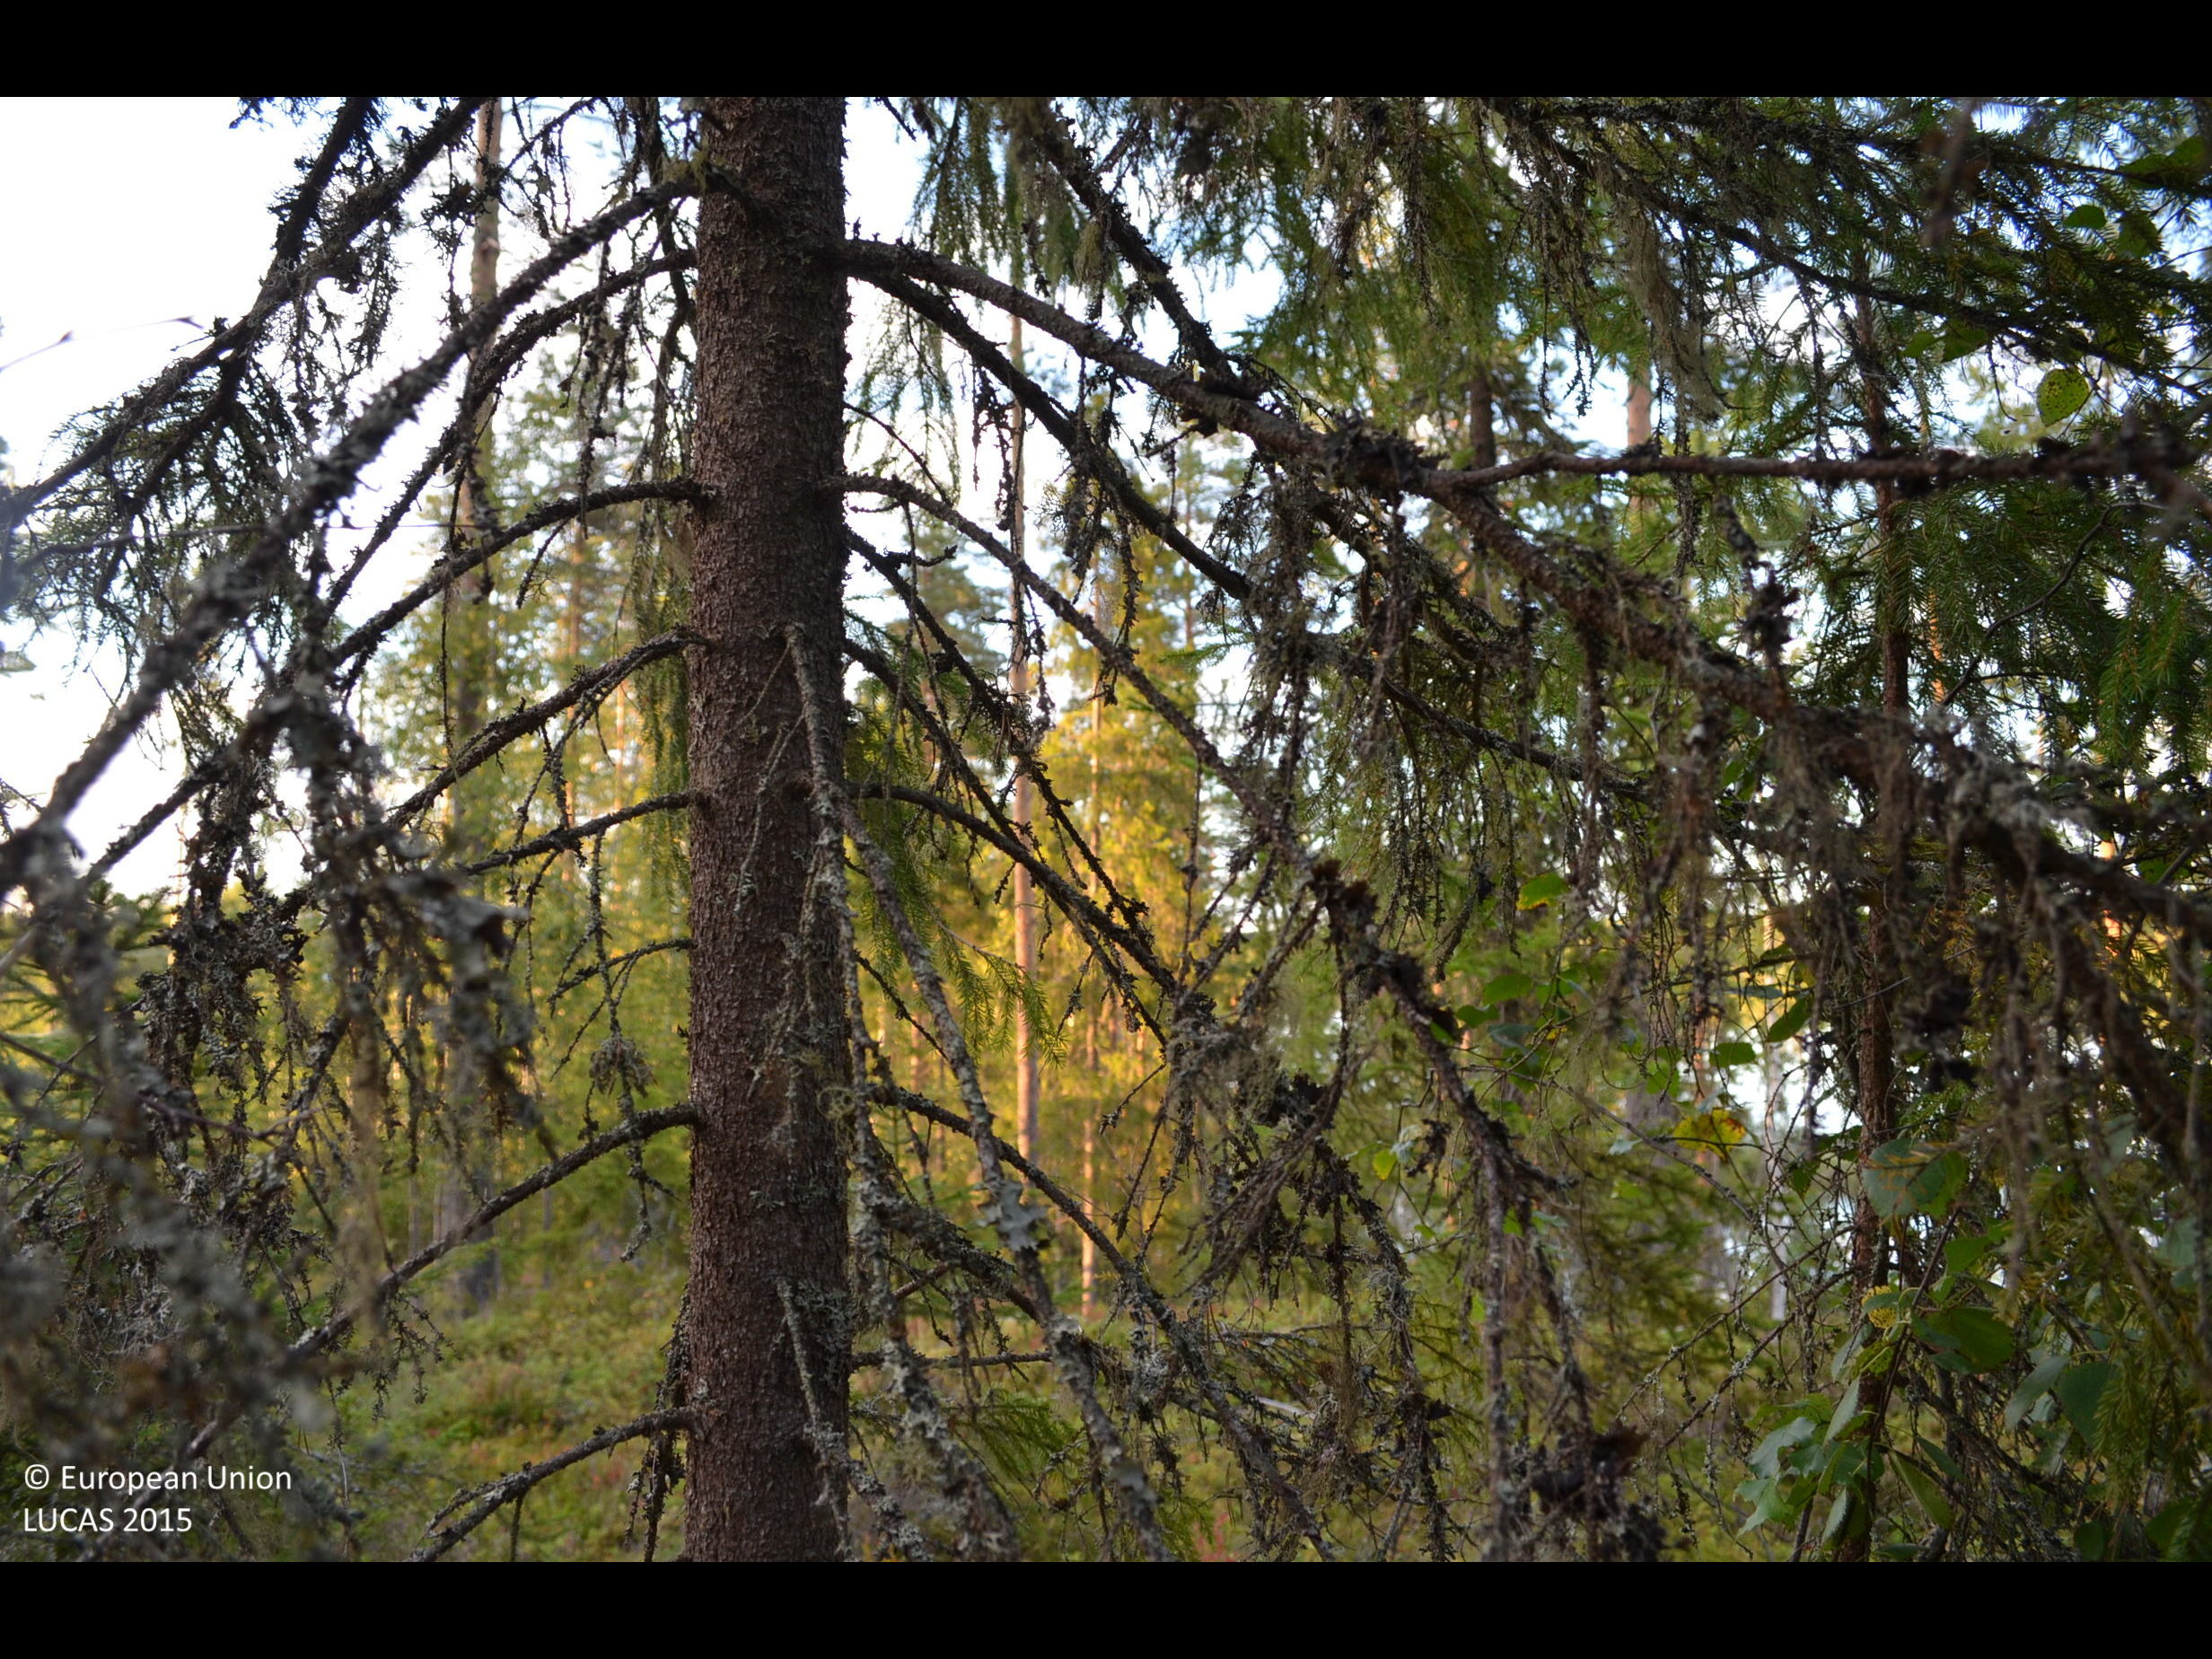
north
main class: Woodland
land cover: Other coniferous woodland
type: boreal forest
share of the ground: 50 - 75 %
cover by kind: coniferous forest trees 50 %, shrubs 30 %, broadleaved forest trees 10 %
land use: Forestry
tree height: > 5 m
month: August
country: FI
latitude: 62.4097
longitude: 23.6415
